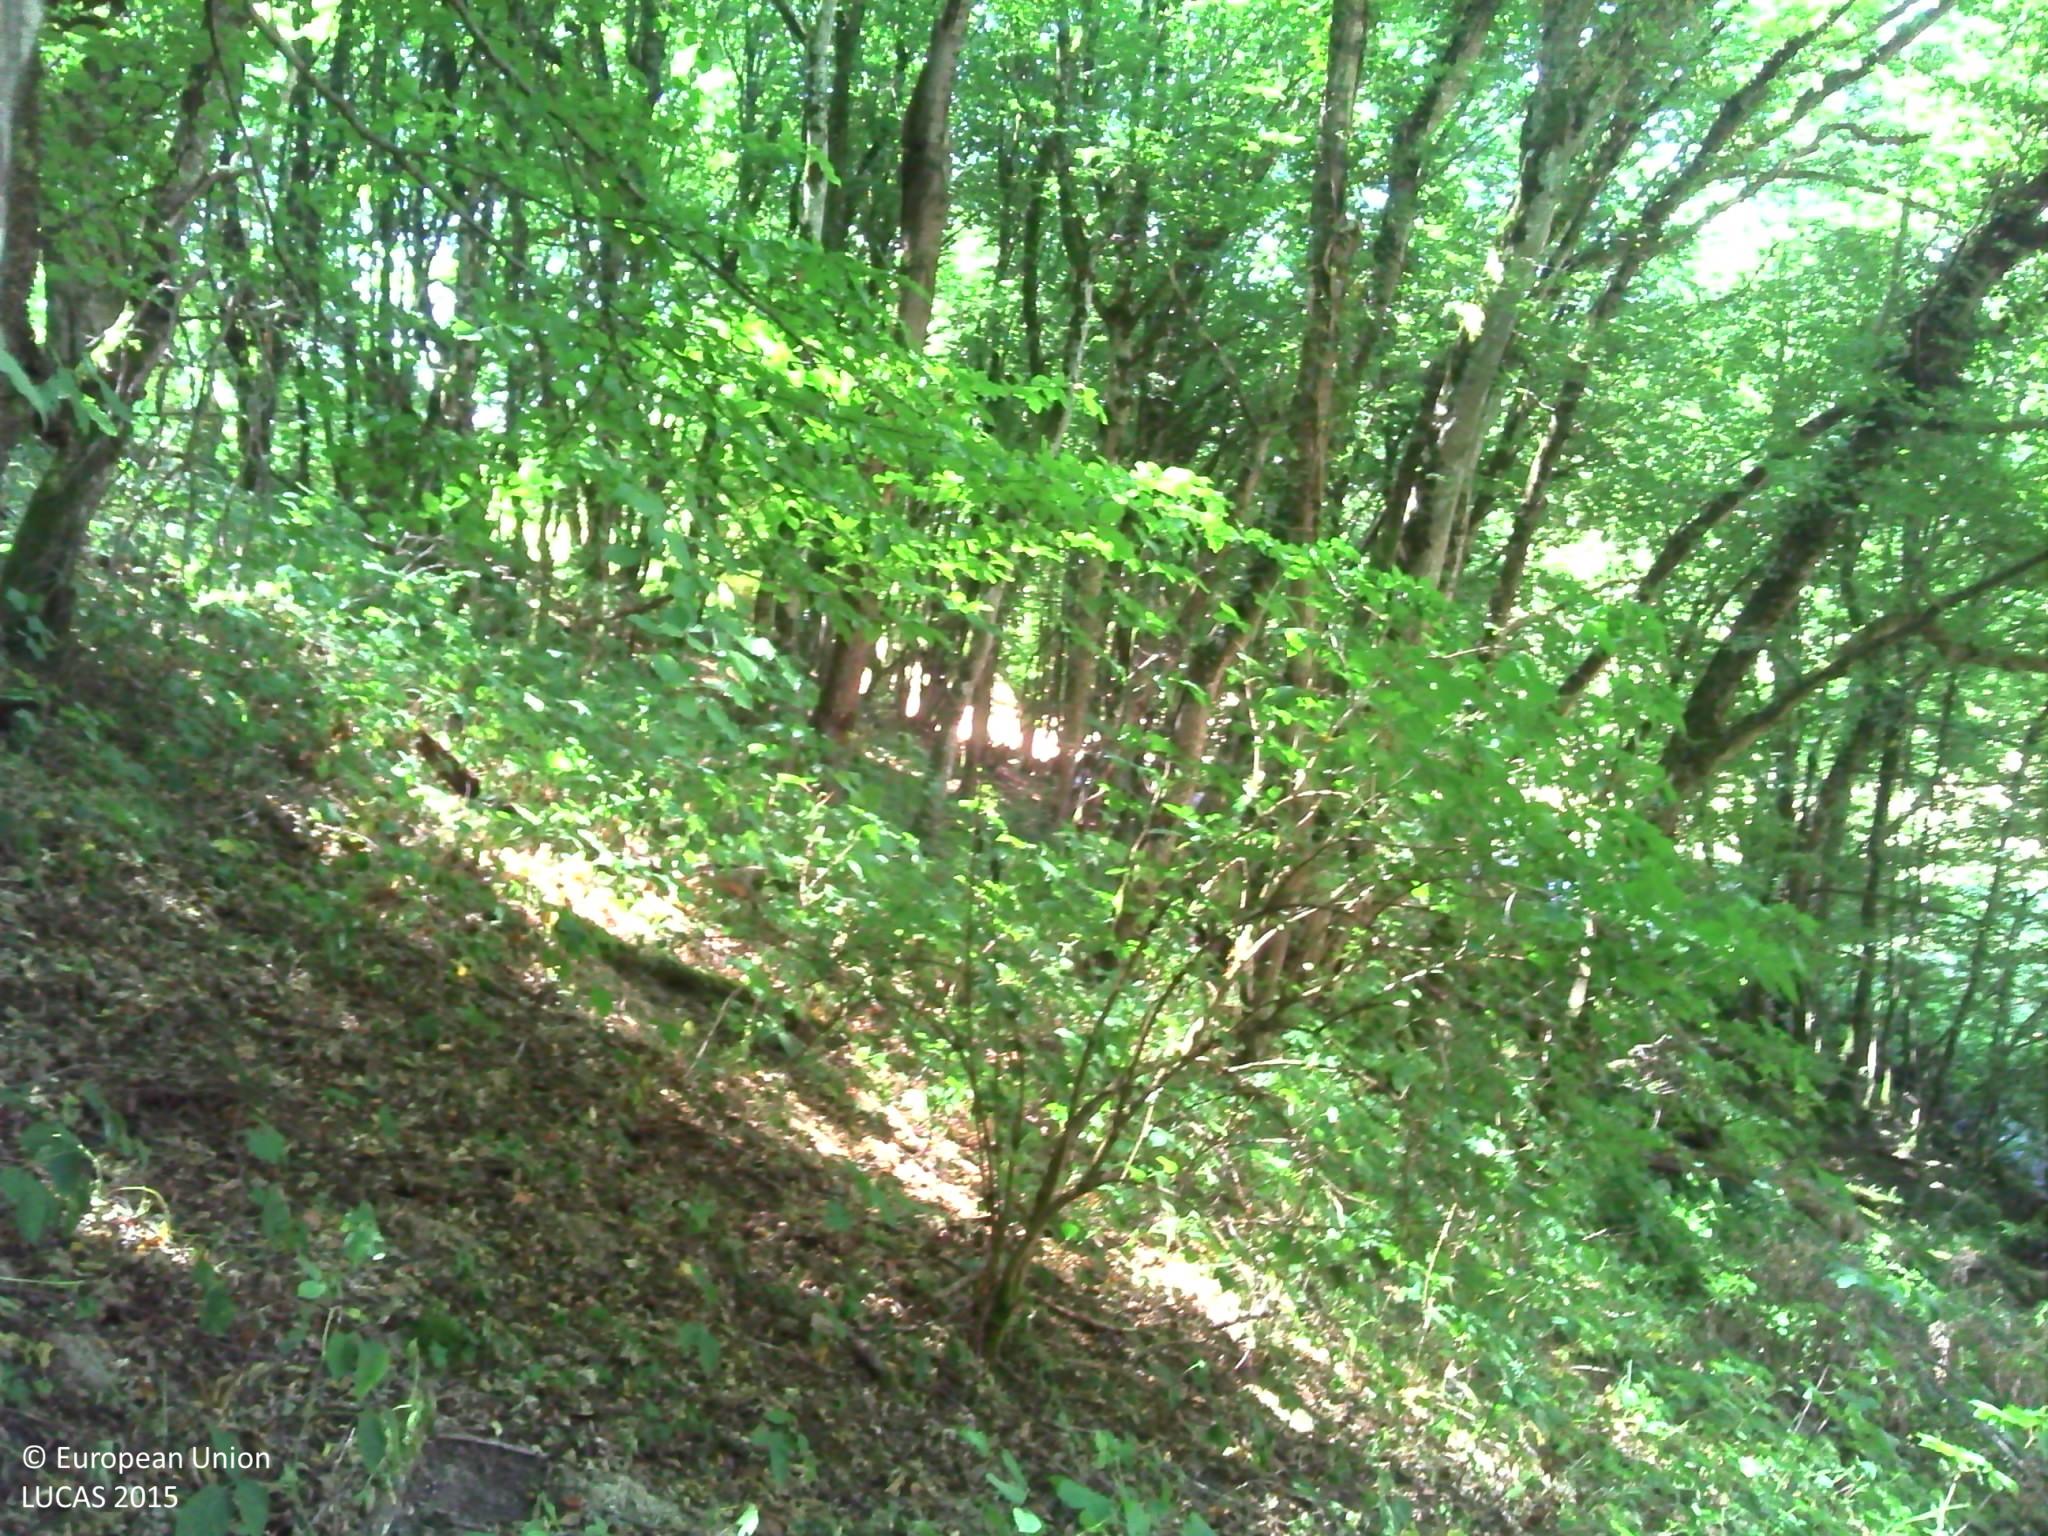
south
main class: Woodland
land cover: Broadleaved woodland
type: mesophytic deciduous forest
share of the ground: > 75 %
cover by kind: broadleaved forest trees 100 %
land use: Forestry
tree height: > 5 m
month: July
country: FR
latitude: 46.8168
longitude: 4.0361
